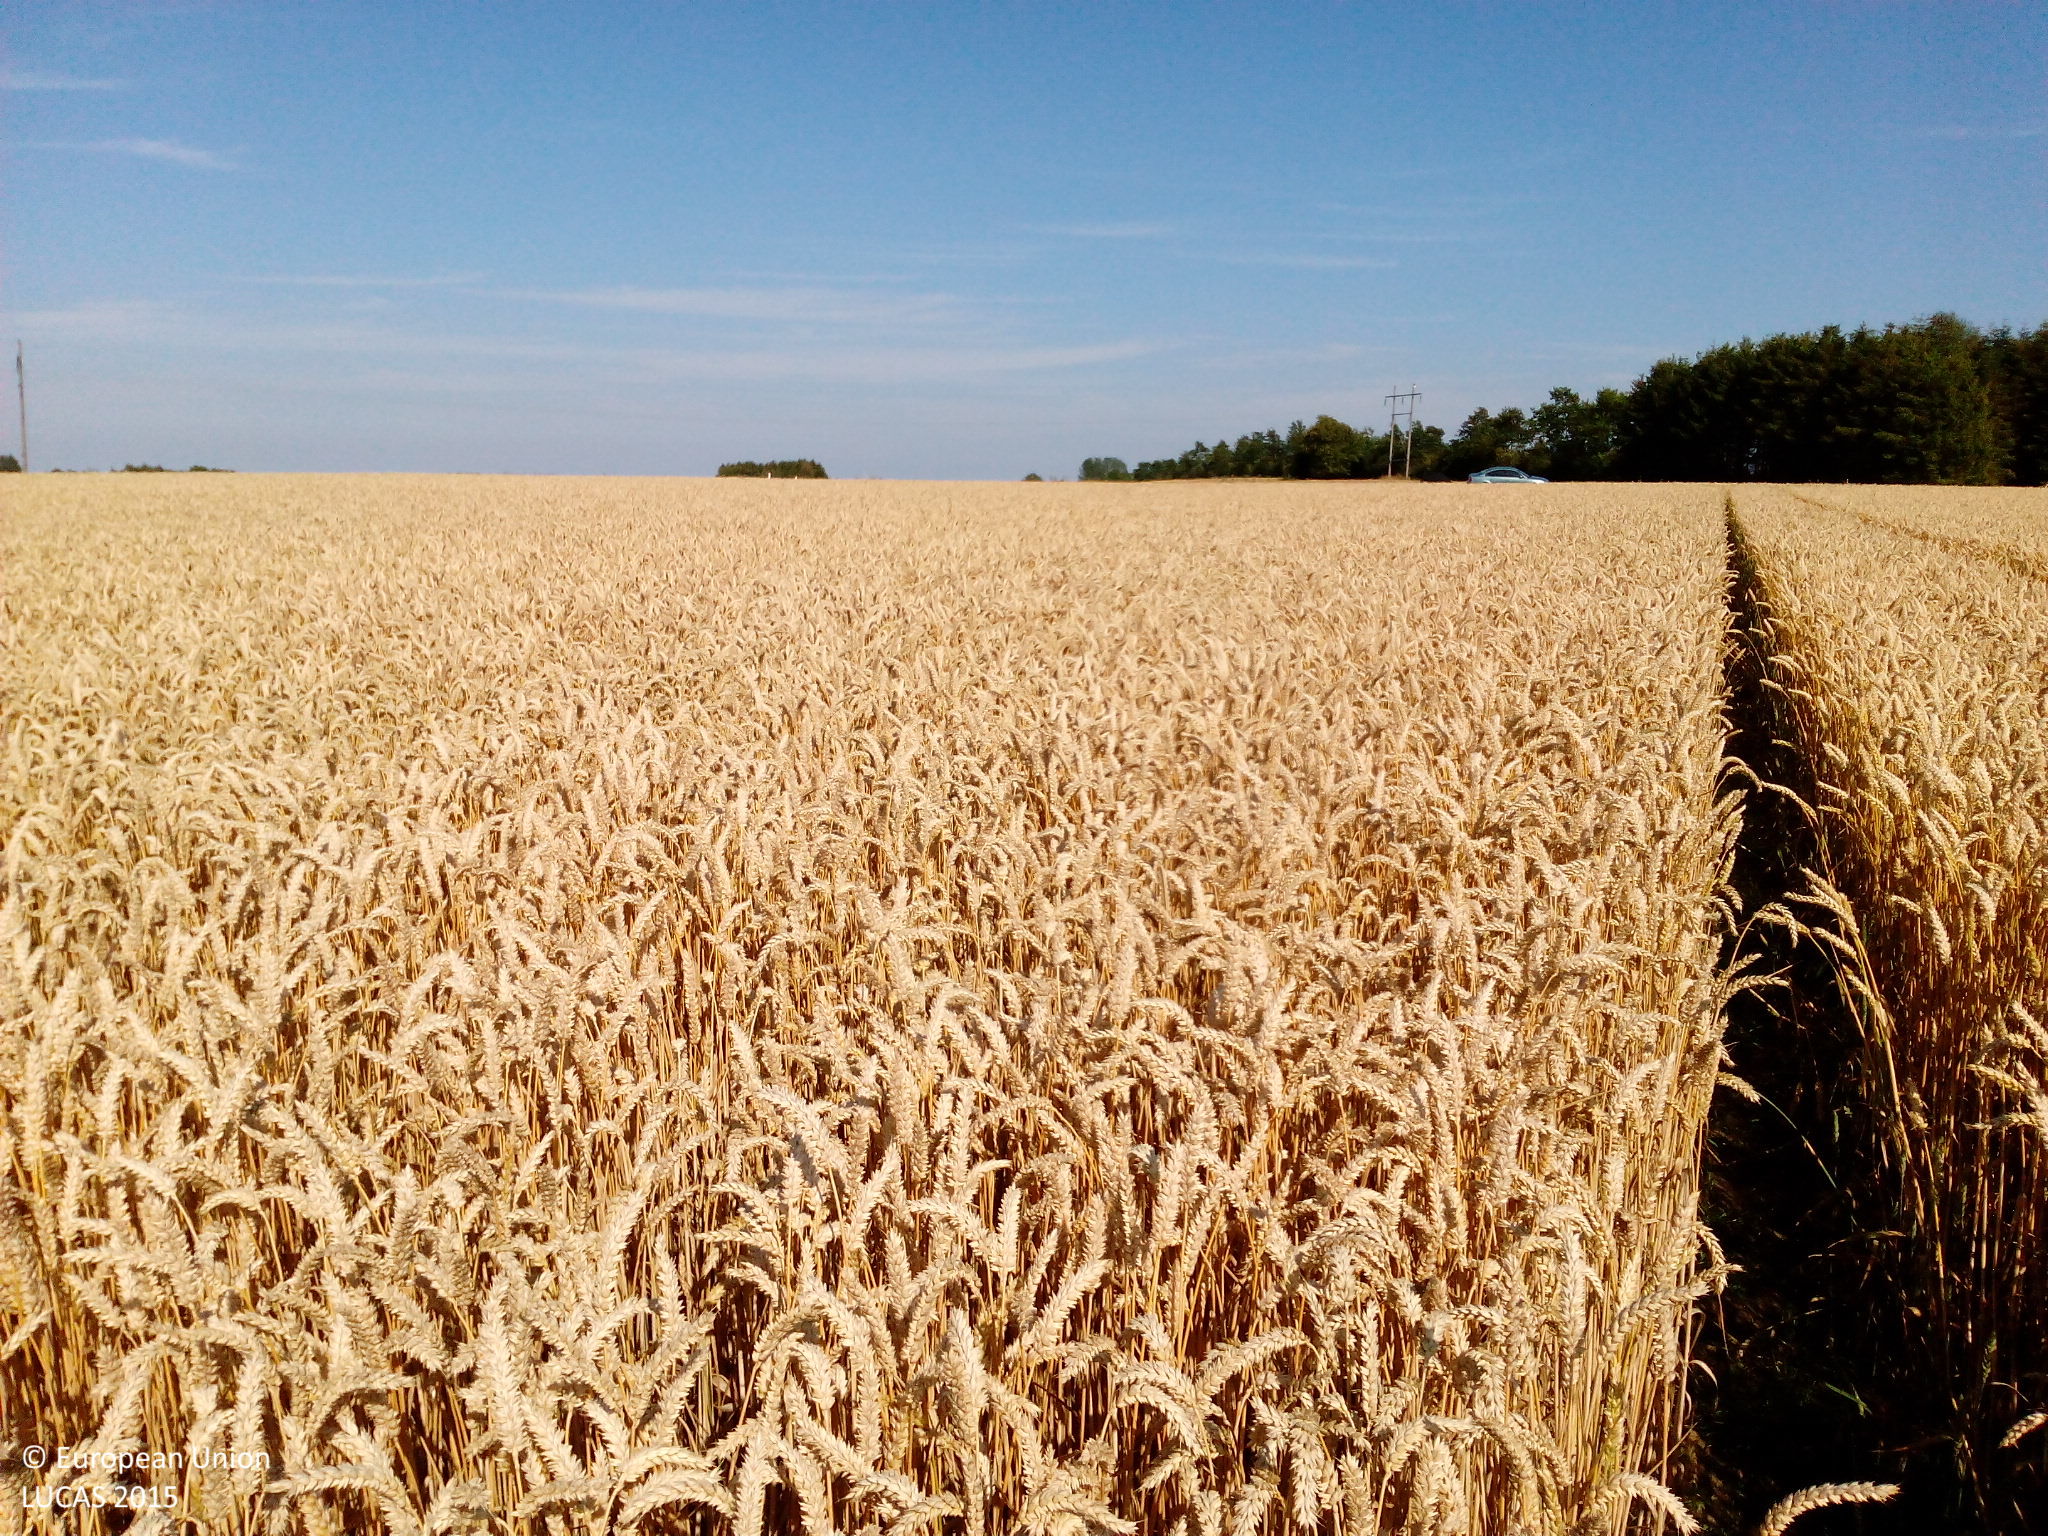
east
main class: Cropland
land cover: Common wheat
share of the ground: > 75 %
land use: Agriculture (excluding fallow land and kitchen gardens)
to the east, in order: Common wheat; Grass margins; Paved roads, cycling and walking lanes; Grass margins; Barley; Temporary grasslands; Electric lines; Temporary grasslands; Barley
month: August
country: DK
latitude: 55.4023
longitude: 11.7830
